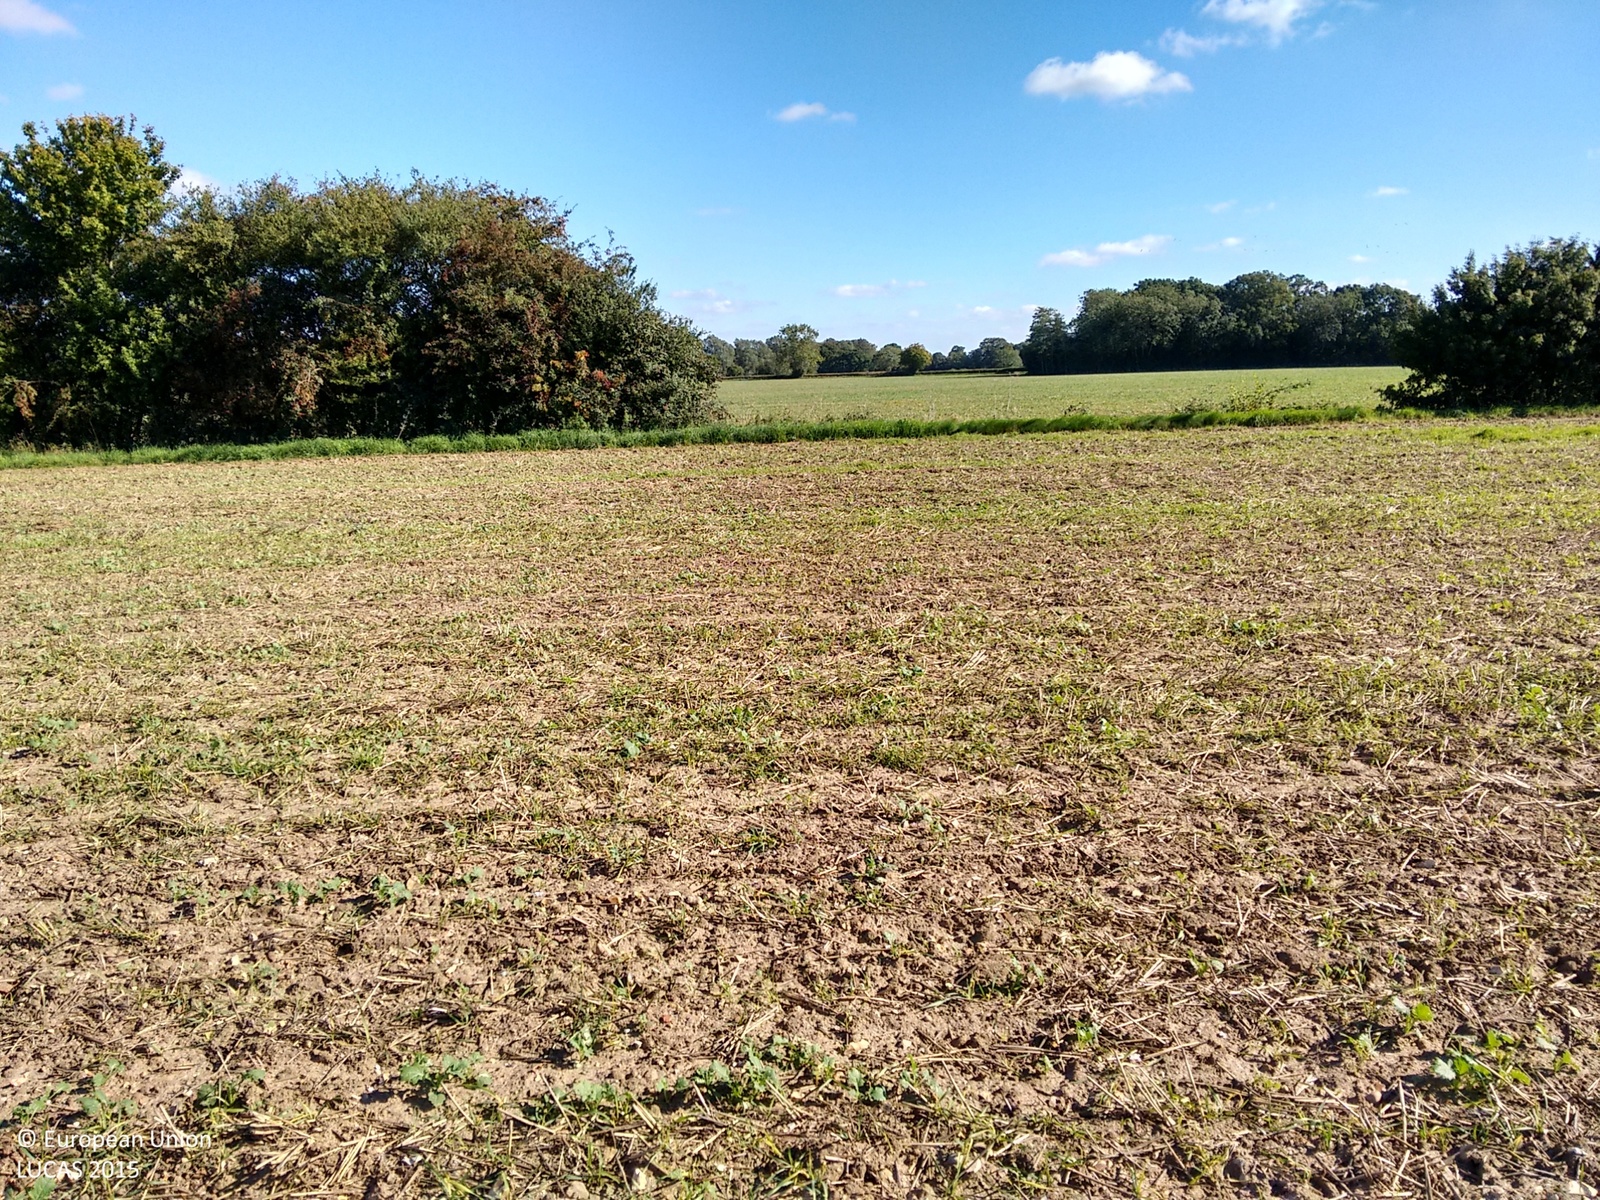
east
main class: Cropland
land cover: Rape and turnip rape
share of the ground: > 75 %
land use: Agriculture (excluding fallow land and kitchen gardens)
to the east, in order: Rape and turnip rape; Grass margins; Ditches and canals; Abandoned hedges; Grass margins; Rape and turnip rape
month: October
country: GB
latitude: 52.3494
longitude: 1.3327
